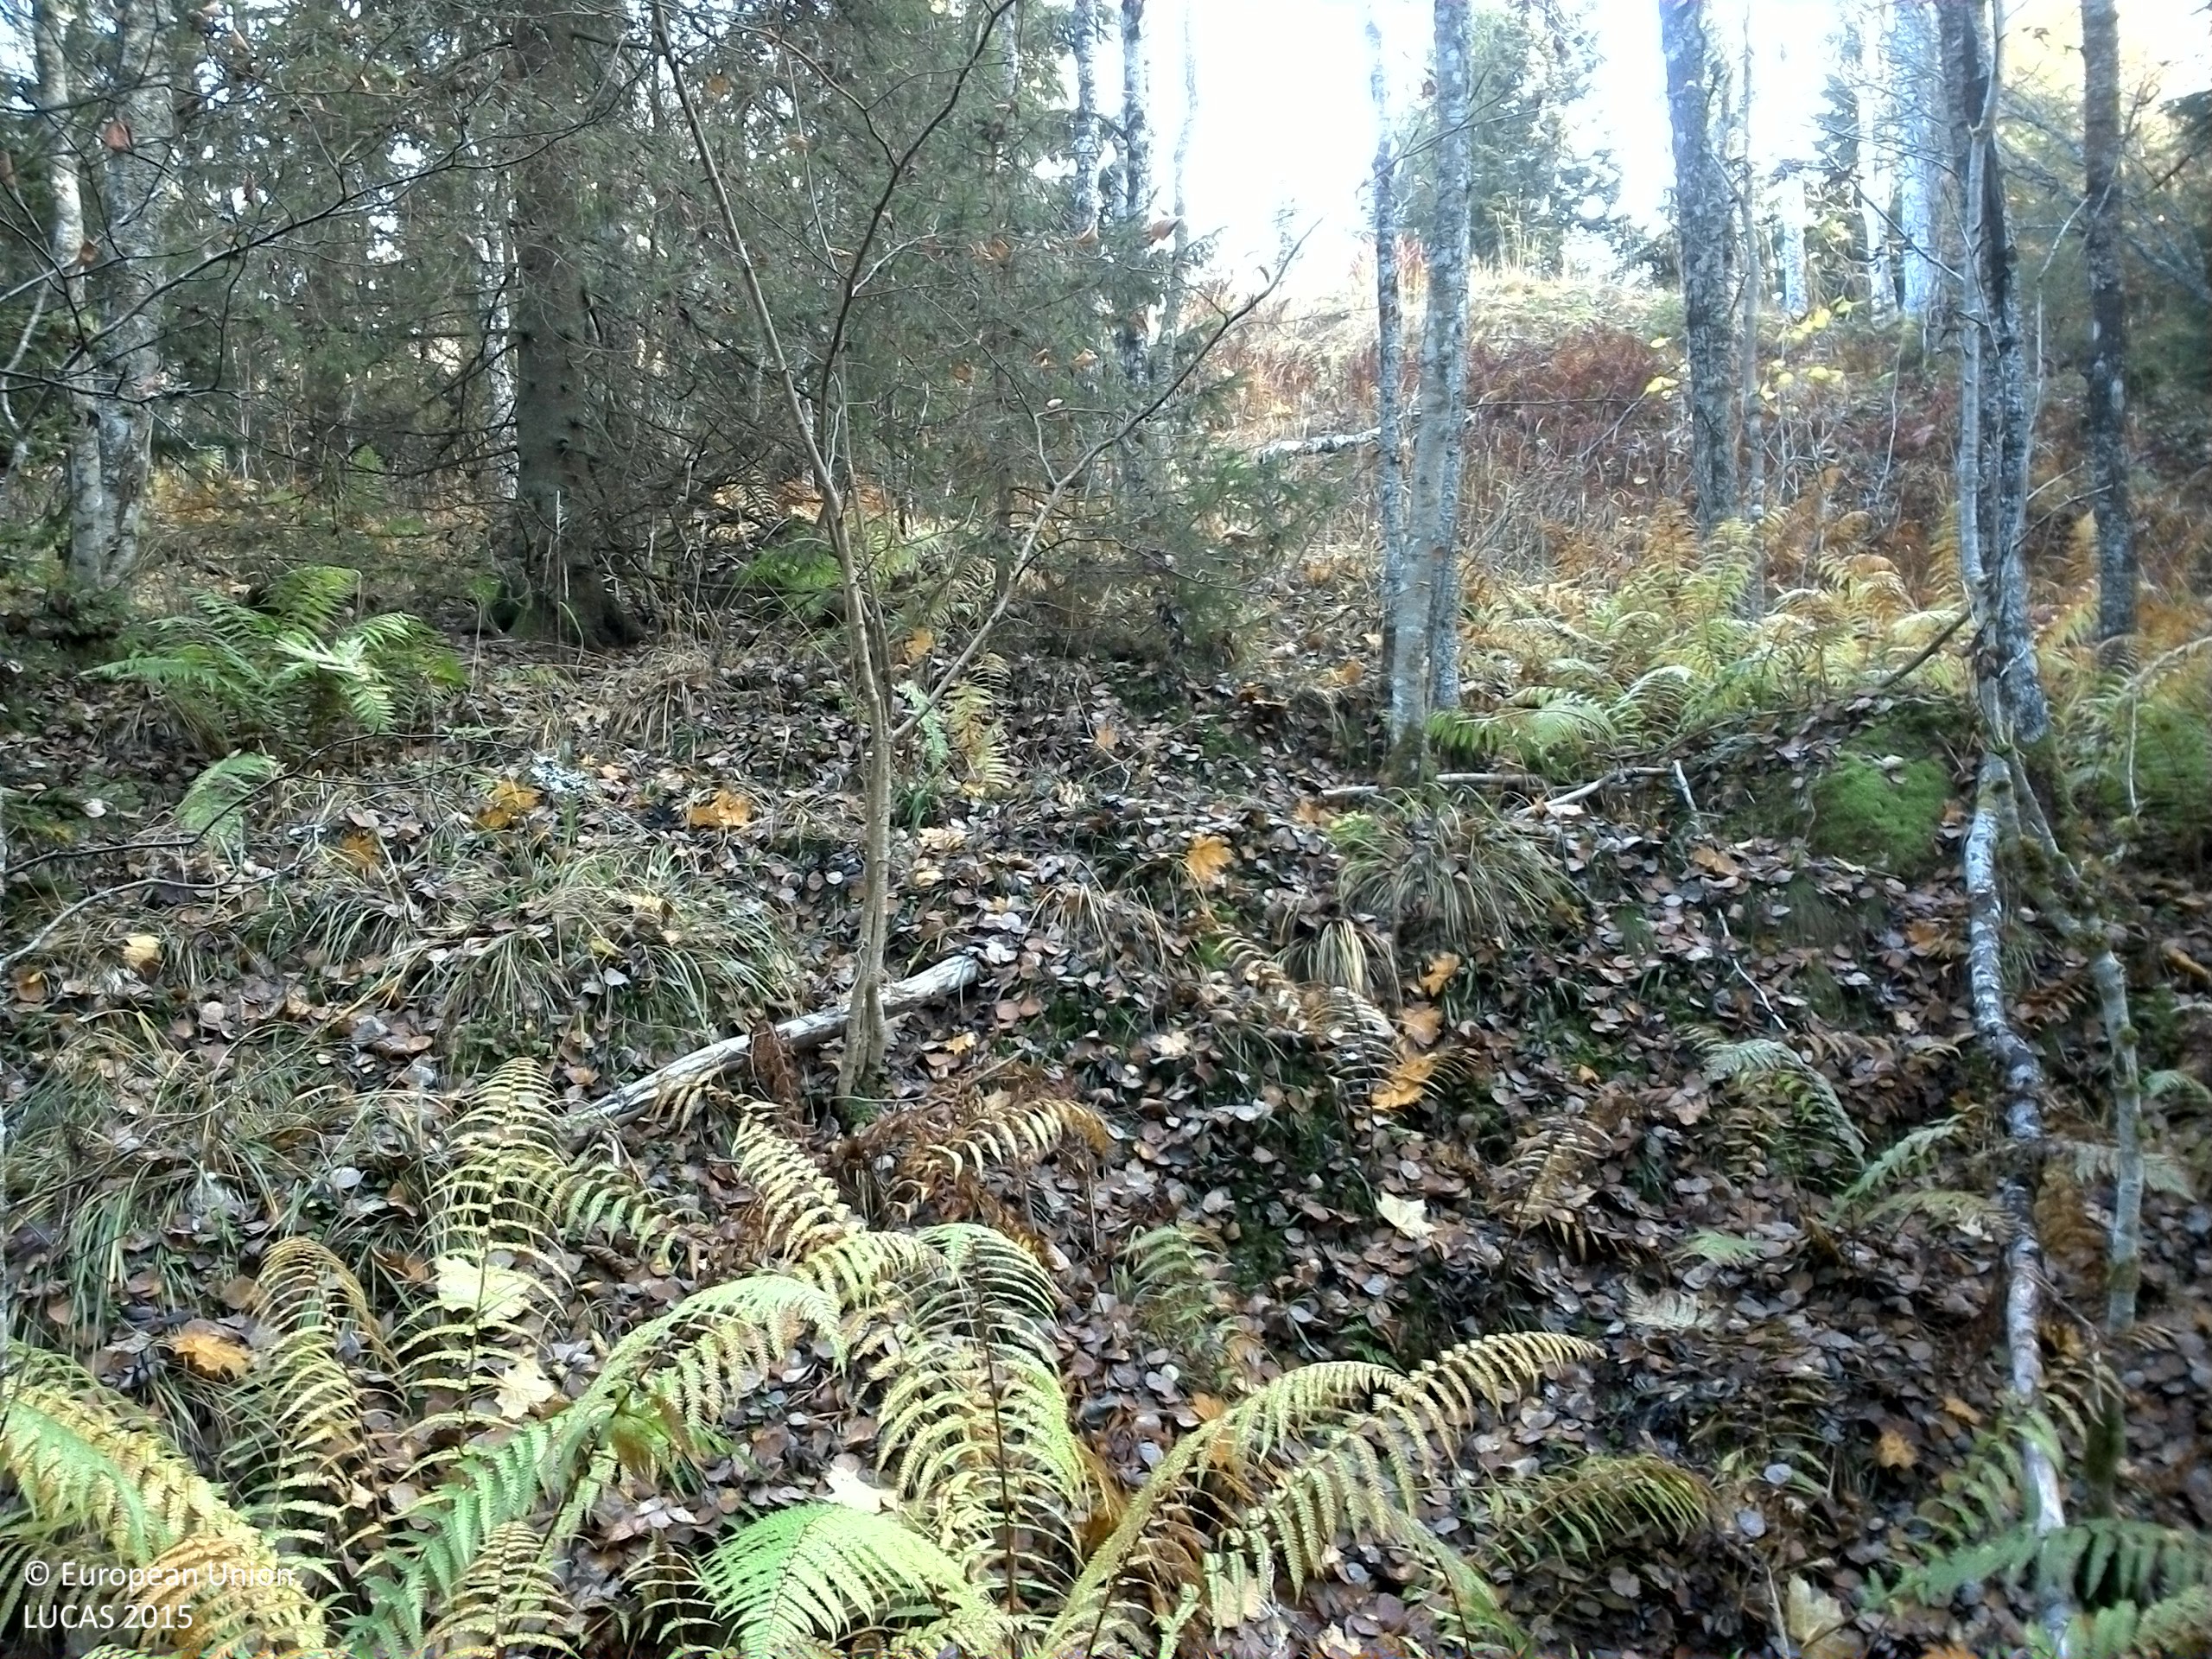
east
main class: Woodland
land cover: Spruce dominated mixed woodland
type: boreal forest
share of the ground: 50 - 75 %
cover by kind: coniferous forest trees 35 %, broadleaved forest trees 35 %, herbaceous plants 20 %, shrubs 10 %
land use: Forestry
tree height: > 5 m
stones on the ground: < 10 %
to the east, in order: Spruce dominated mixed woodland; Other mixed woodland; Broadleaved woodland; Grassland with sparse tree/shrub cover; Spruce dominated mixed woodland; Broadleaved woodland; Spruce dominated mixed woodland; Spruce dominated coniferous woodland; Tracks; Ditches and canals; Spruce dominated mixed woodland; Spruce dominated coniferous woodland
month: November
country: SE
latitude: 57.9233
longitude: 14.6377
